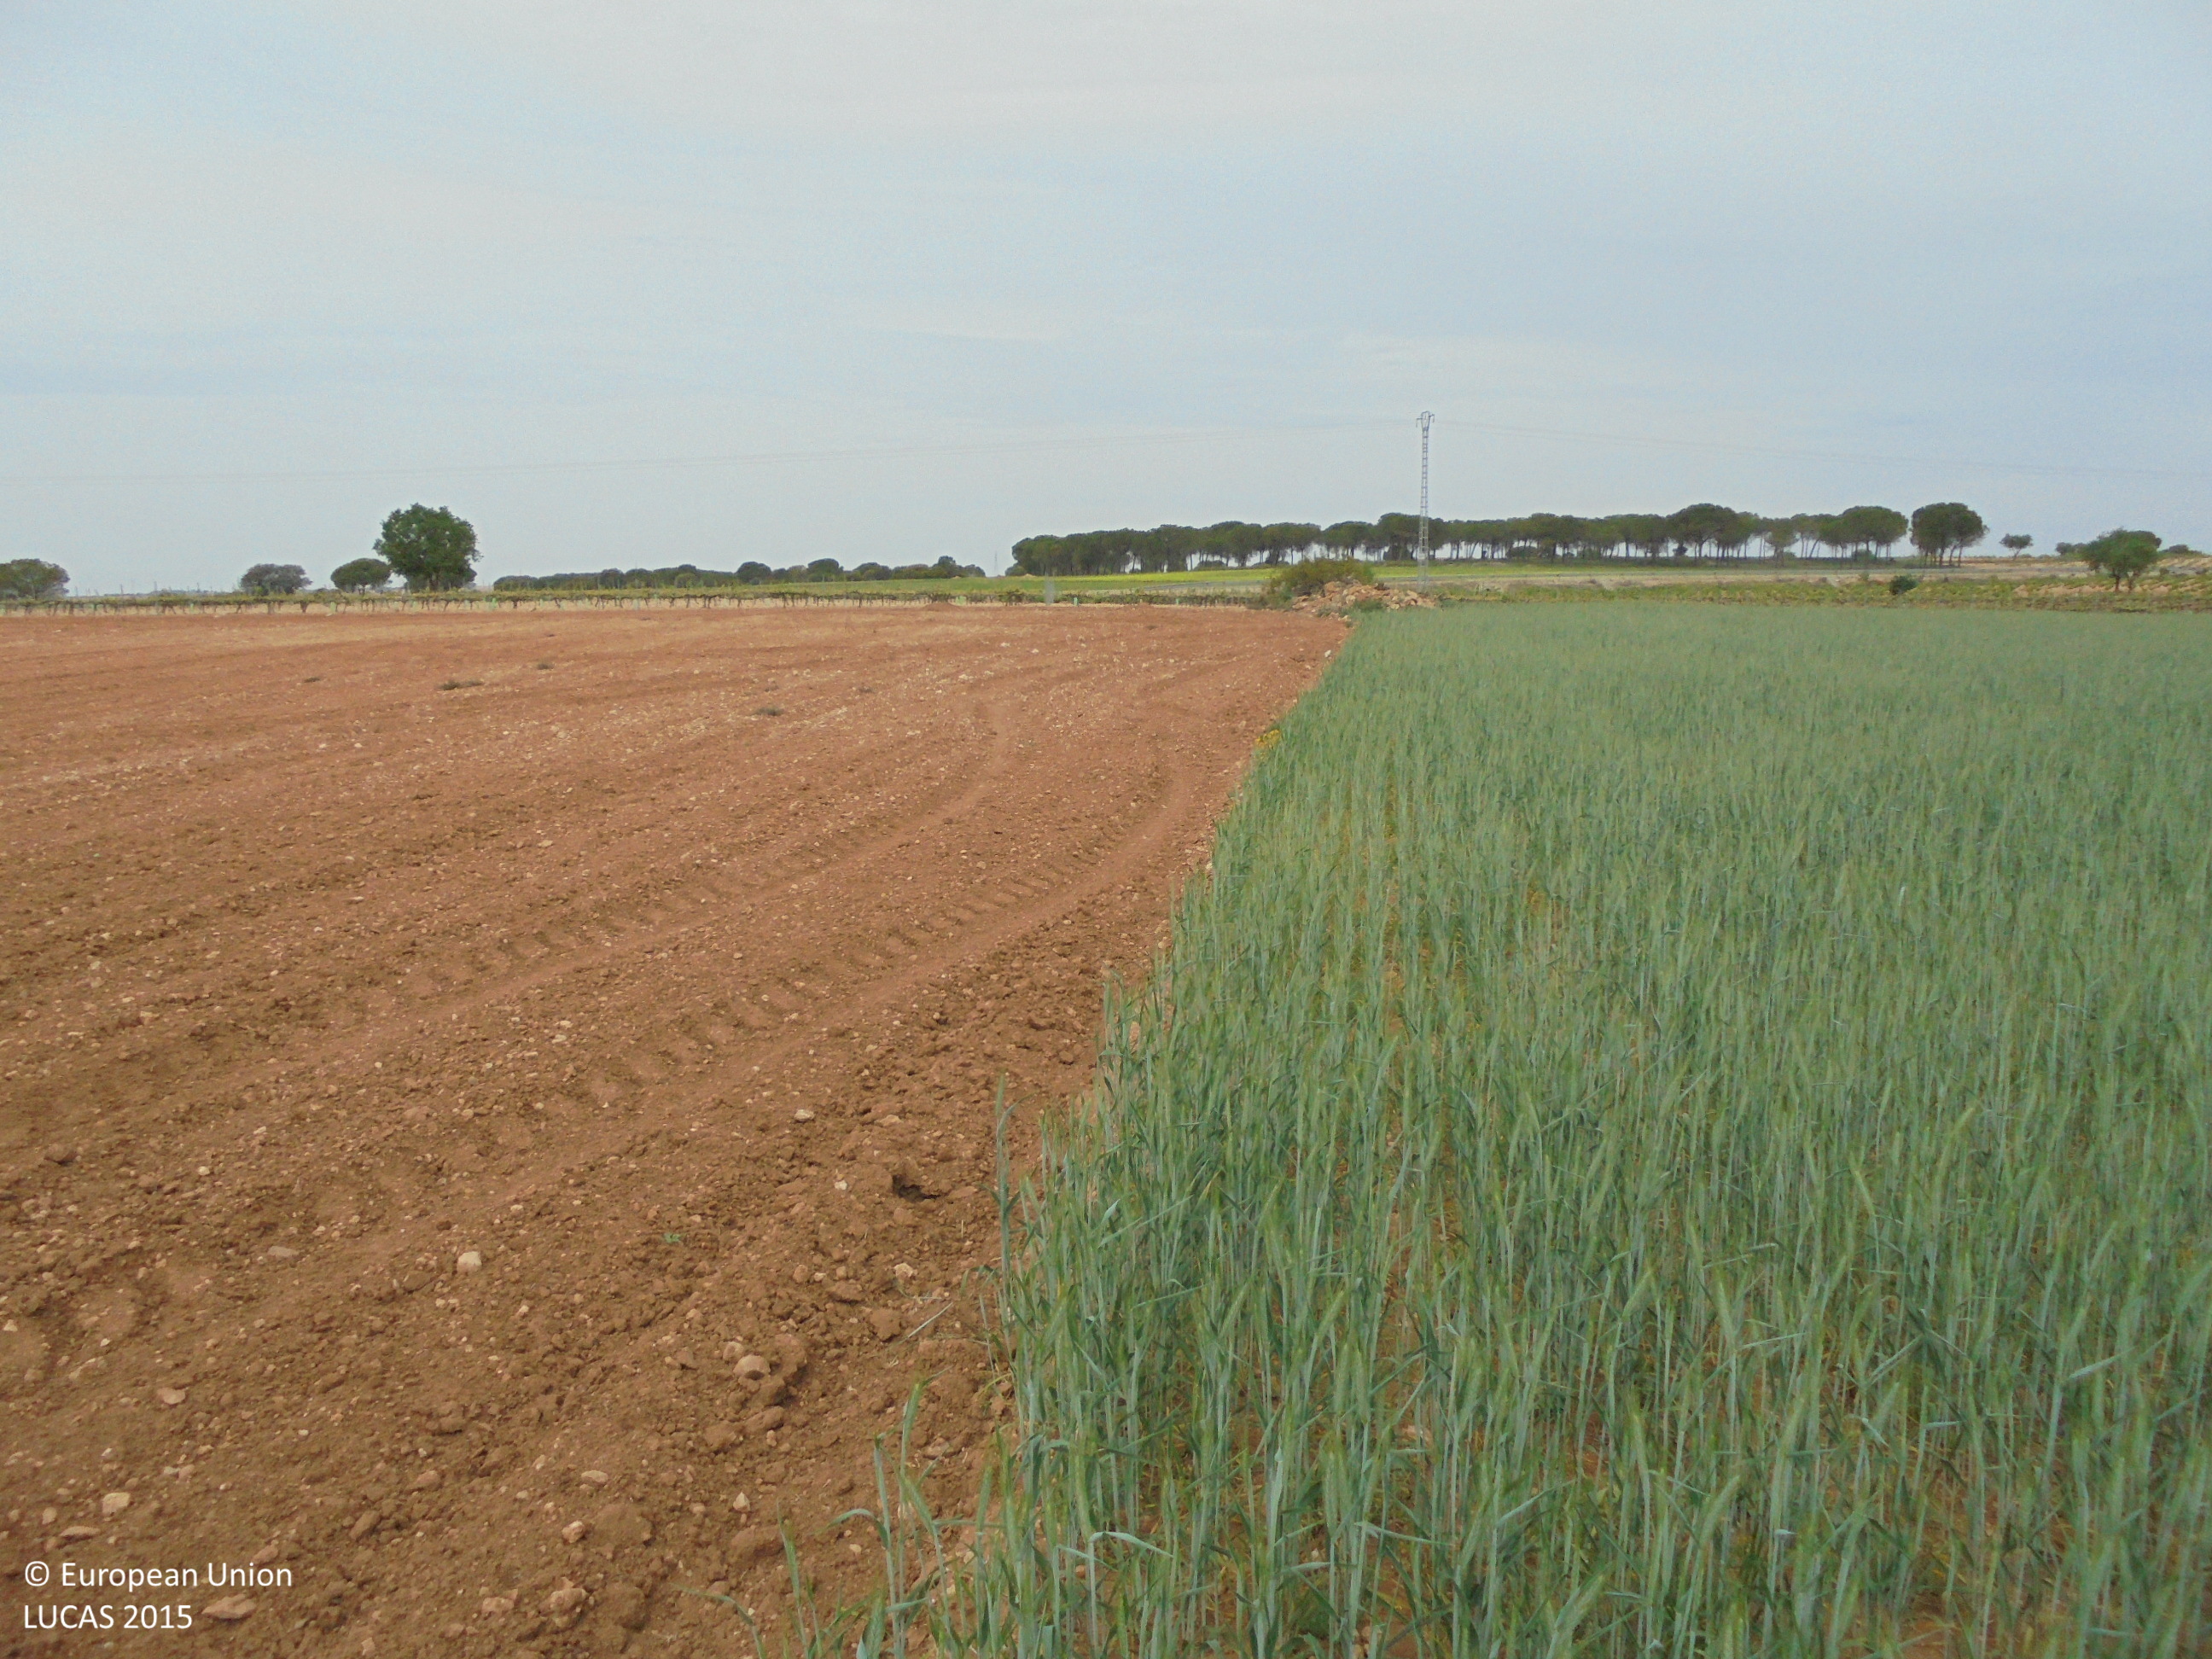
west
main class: Cropland
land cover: Durum wheat
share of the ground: > 75 %
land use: Agriculture (excluding fallow land and kitchen gardens)
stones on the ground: 10 - 25 %
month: May
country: ES
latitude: 39.2520
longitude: -1.7180
